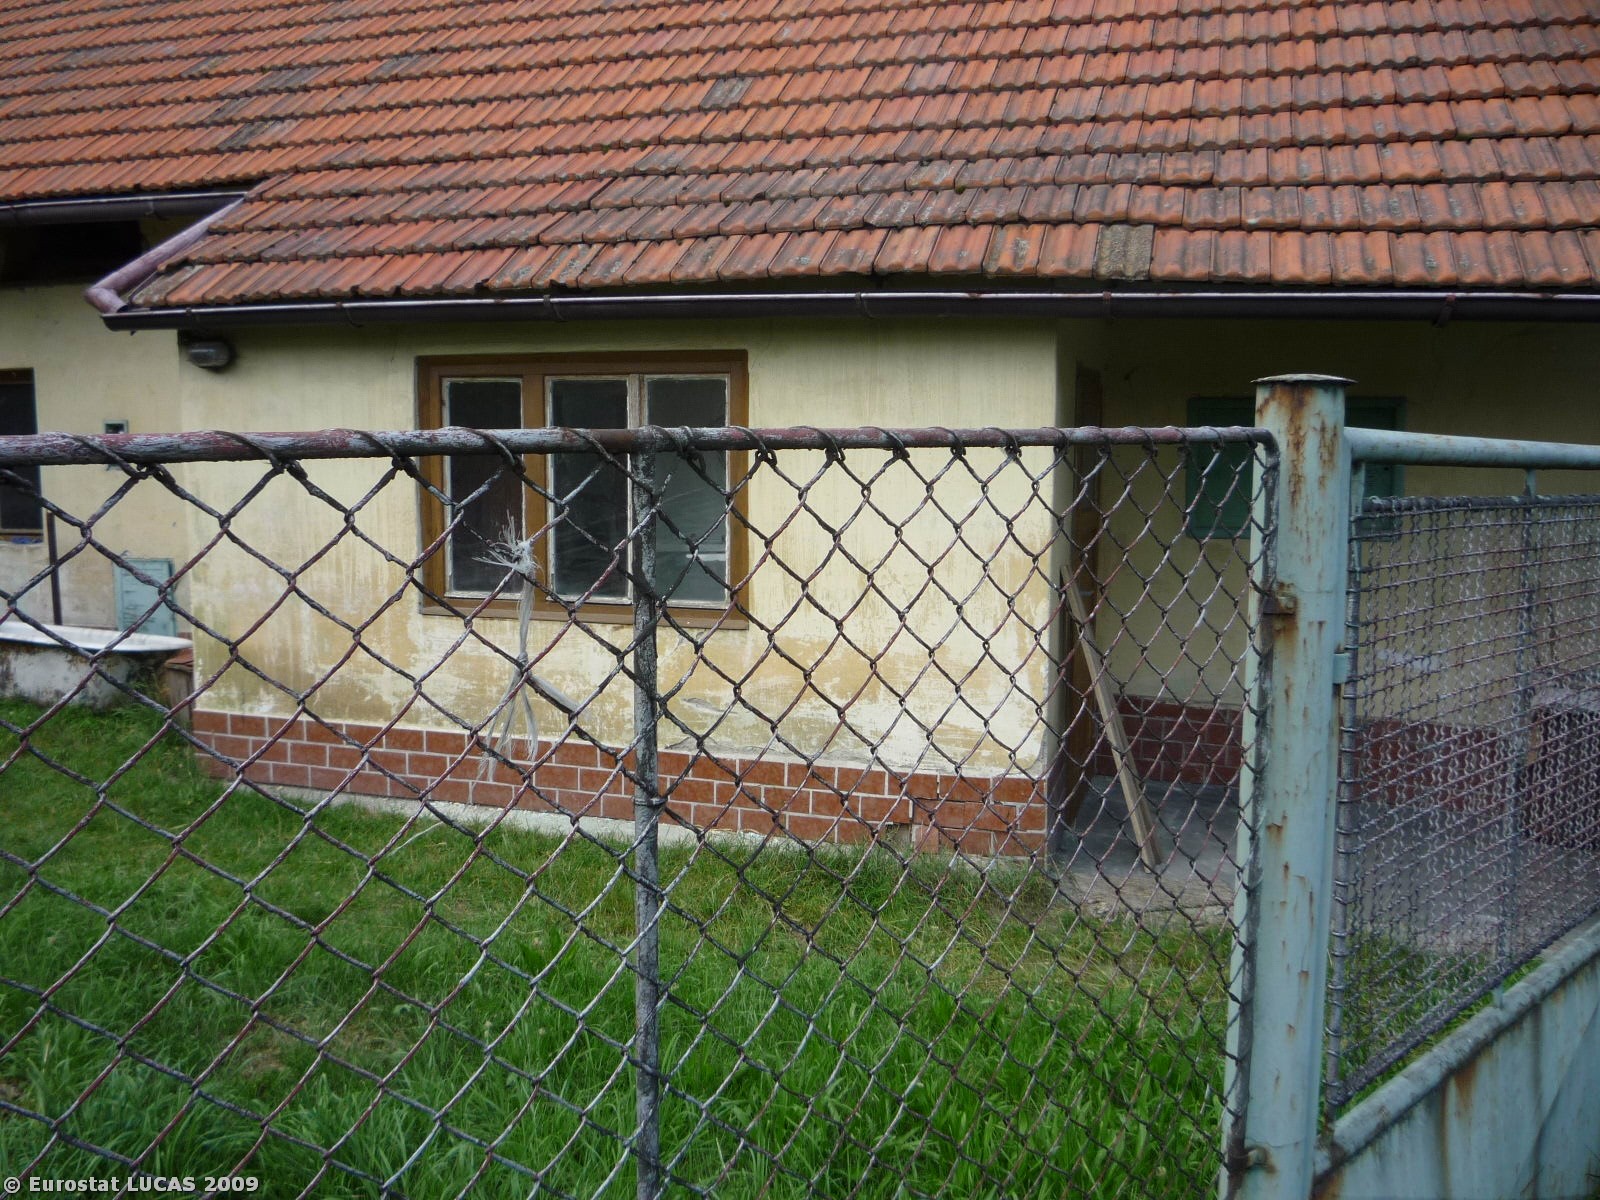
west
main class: Cropland
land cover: Pear fruit
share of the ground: 25 - 50 %
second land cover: Grassland with sparse tree/shrub cover
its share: > 75 %
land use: Kitchen garden
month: July
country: CZ
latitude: 50.1647
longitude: 15.0005
